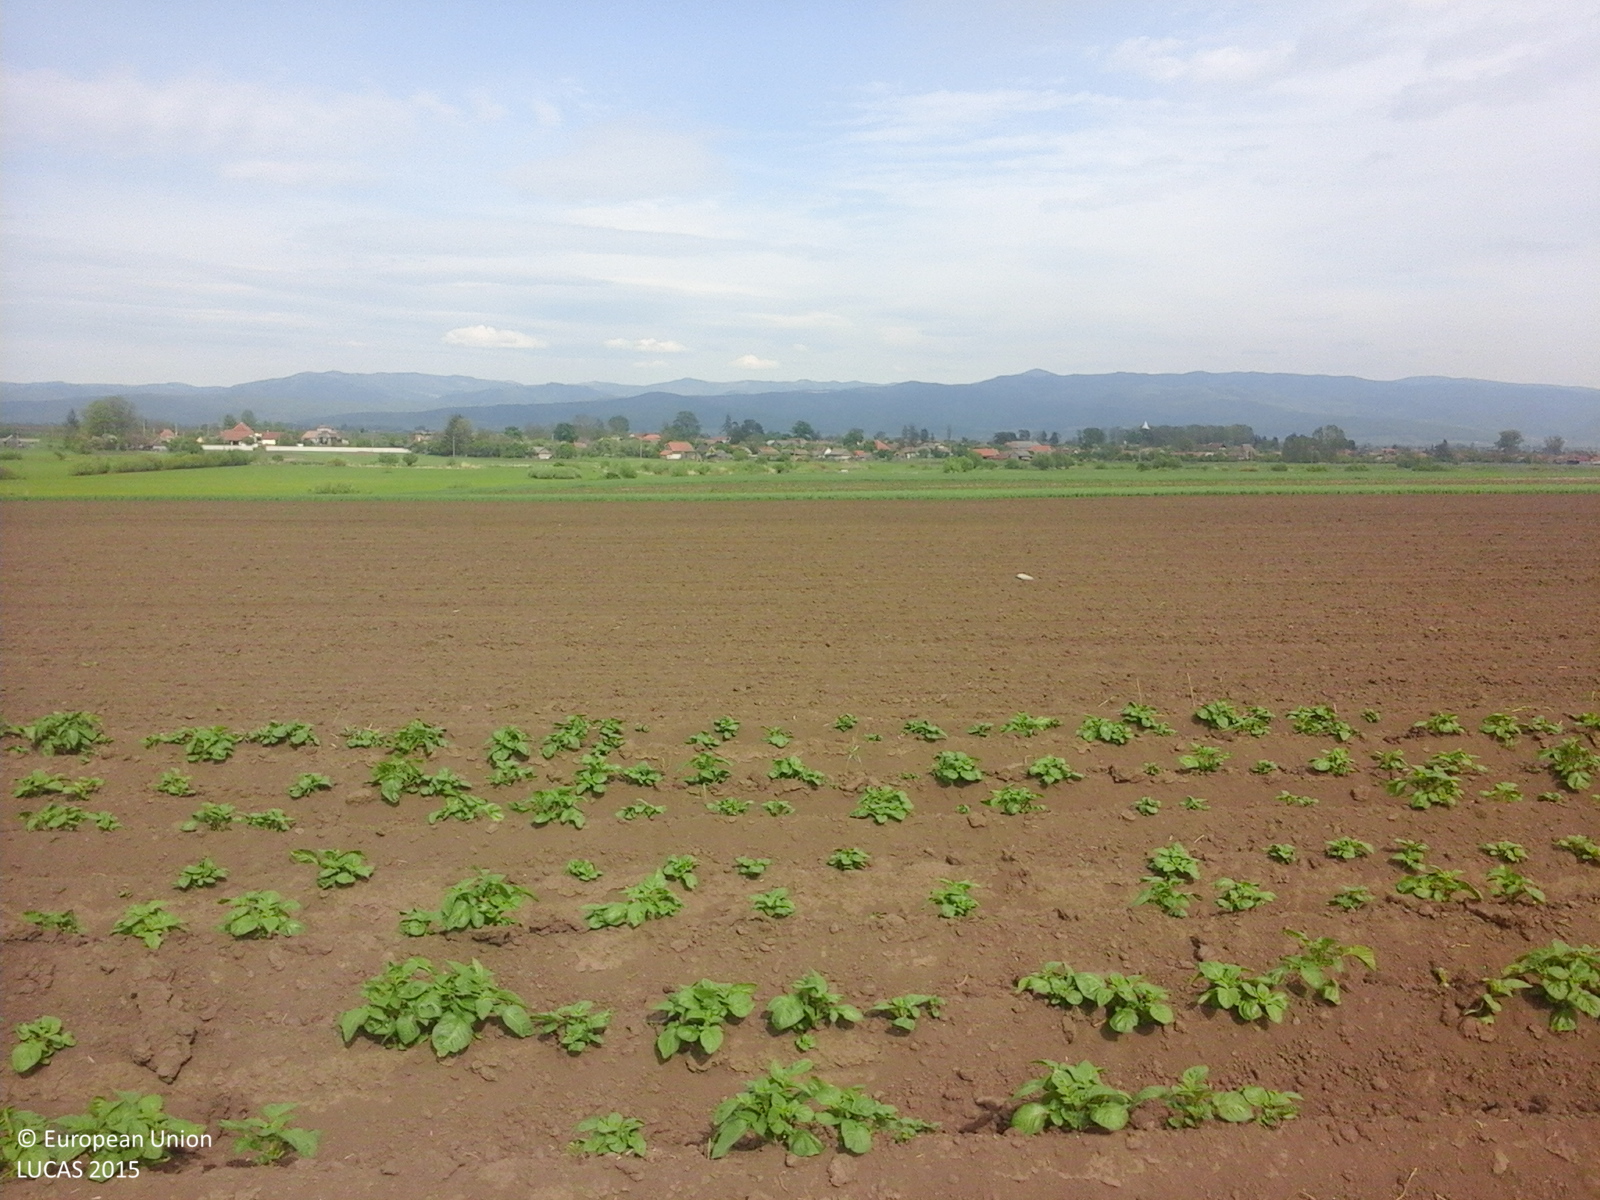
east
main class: Cropland
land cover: Potatoes
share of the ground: 10 - 25 %
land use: Agriculture (excluding fallow land and kitchen gardens)
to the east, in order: Potatoes; Sunflower; Common wheat; Potatoes; Common wheat; Maize
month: May
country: RO
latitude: 45.9195
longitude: 26.0412
